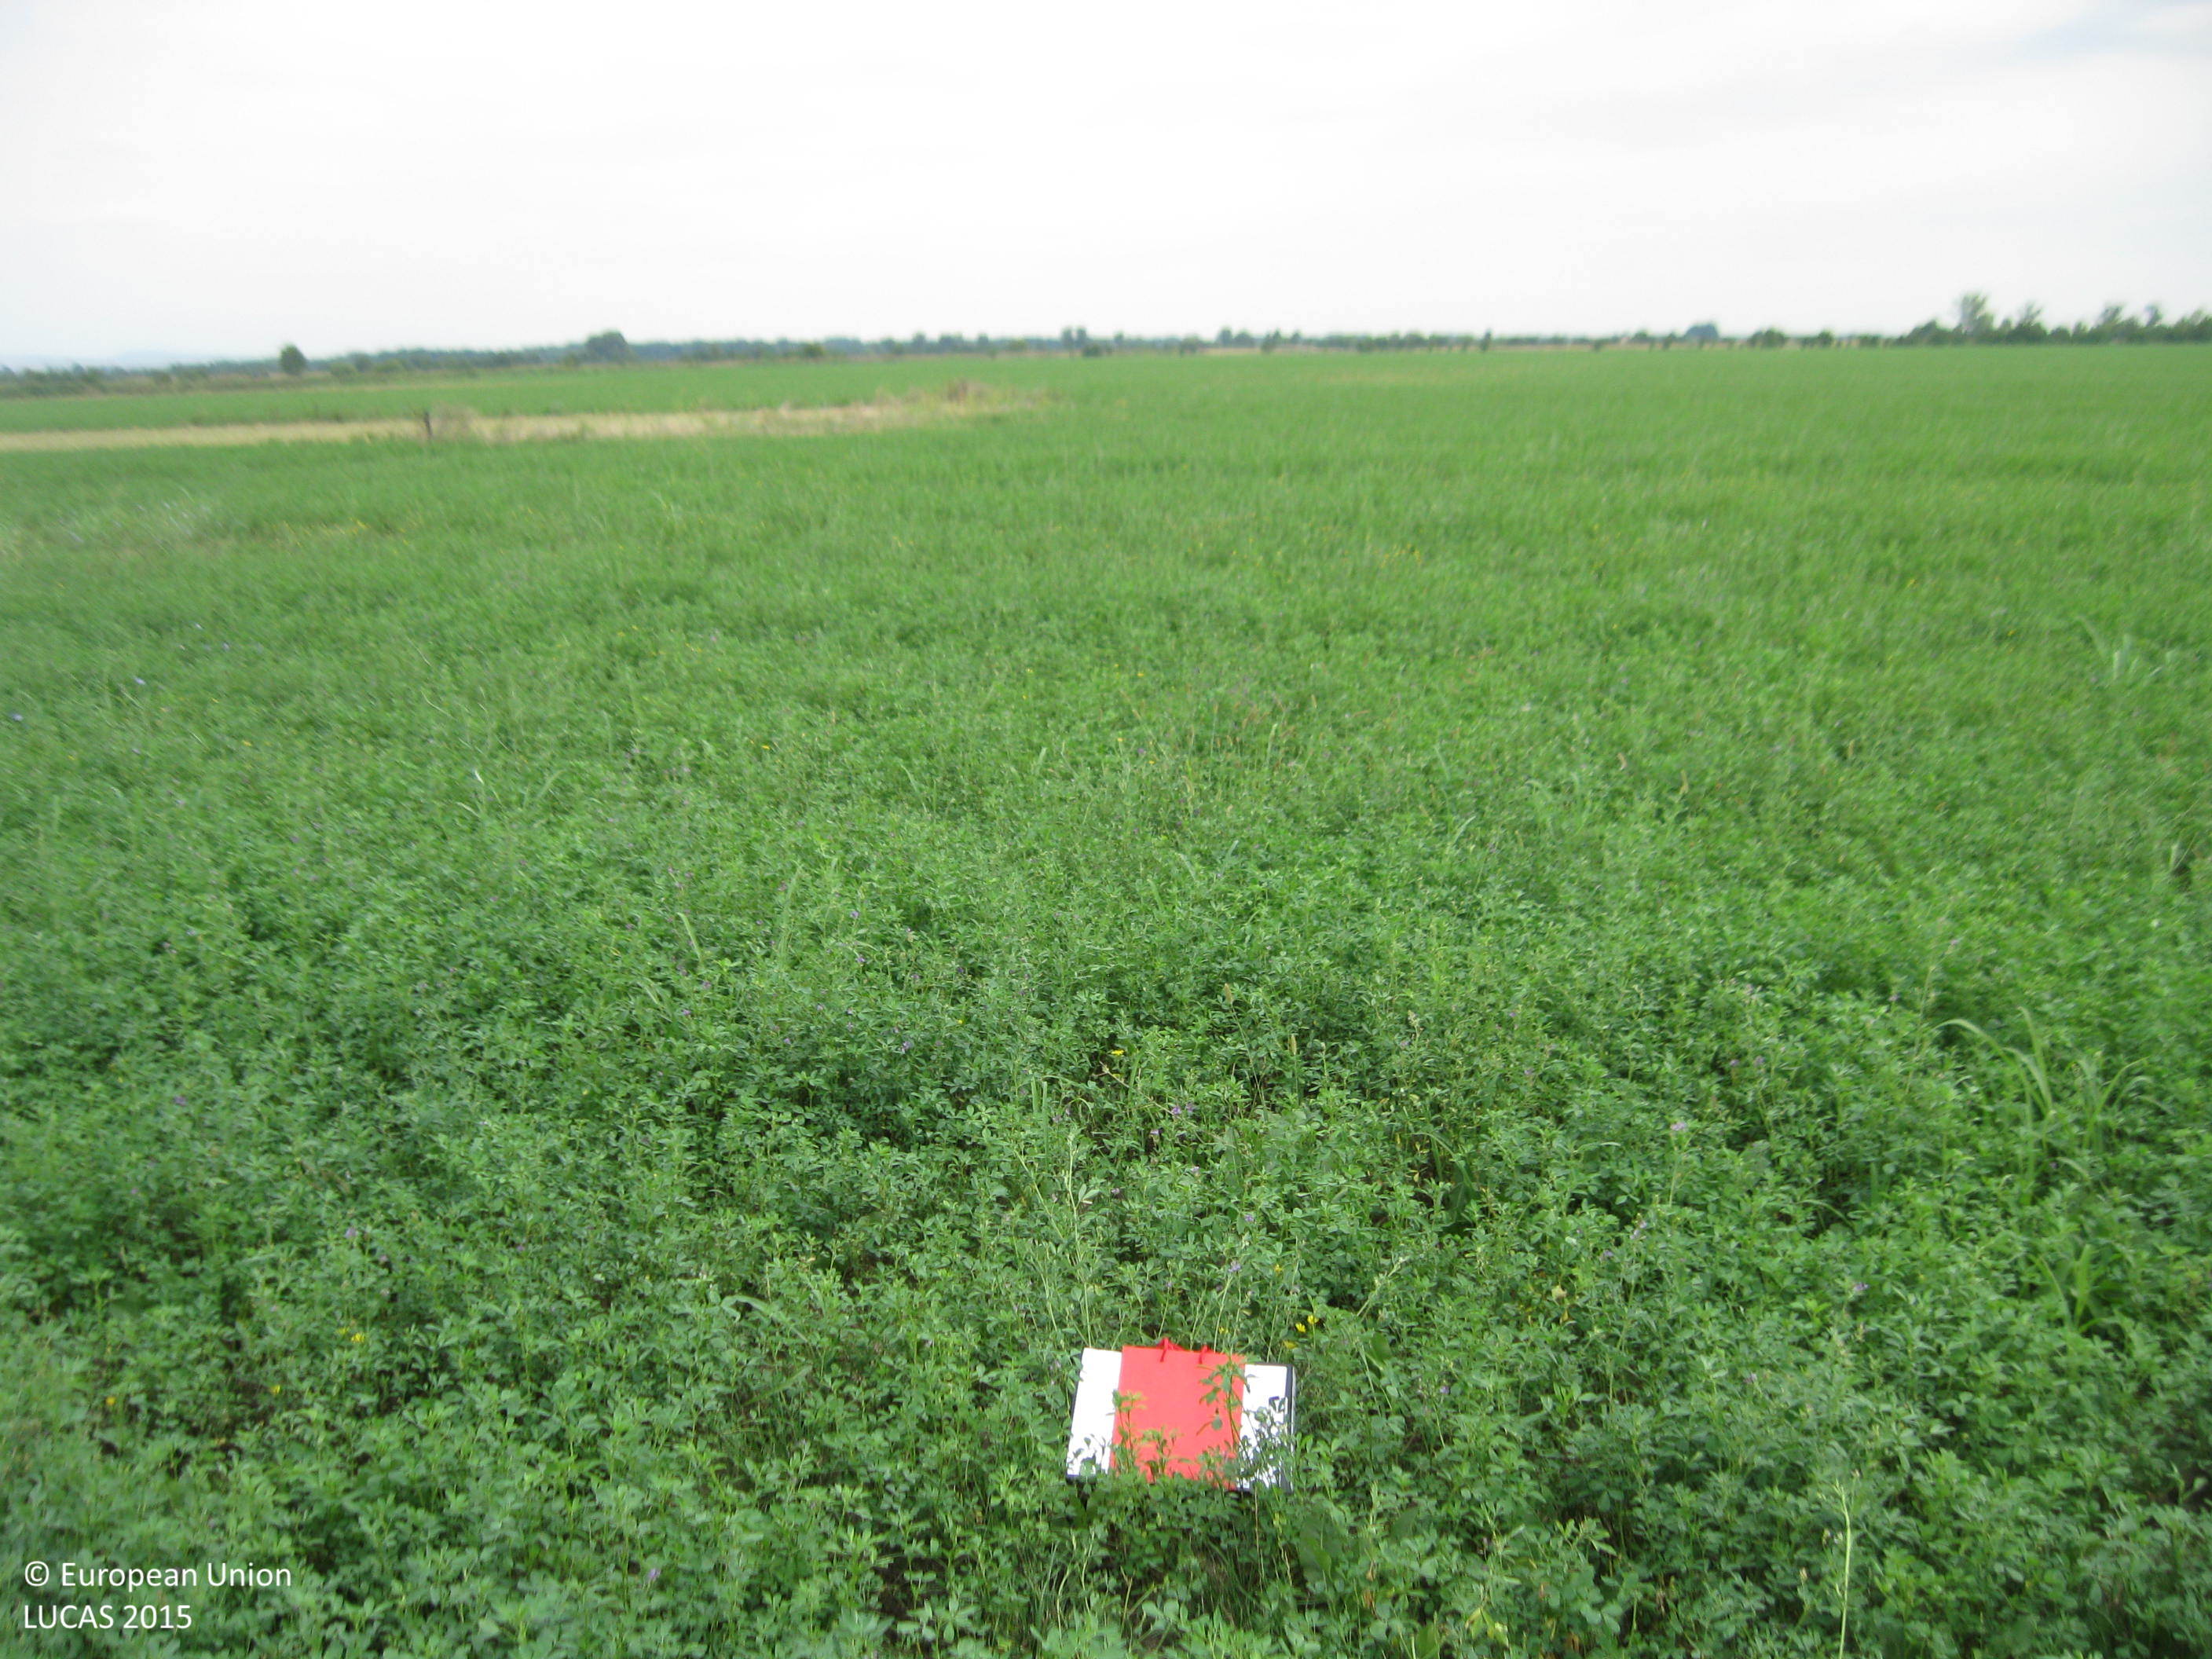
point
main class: Cropland
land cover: Lucerne
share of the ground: > 75 %
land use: Agriculture (excluding fallow land and kitchen gardens)
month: September
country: BG
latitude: 42.1385
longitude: 25.0969
